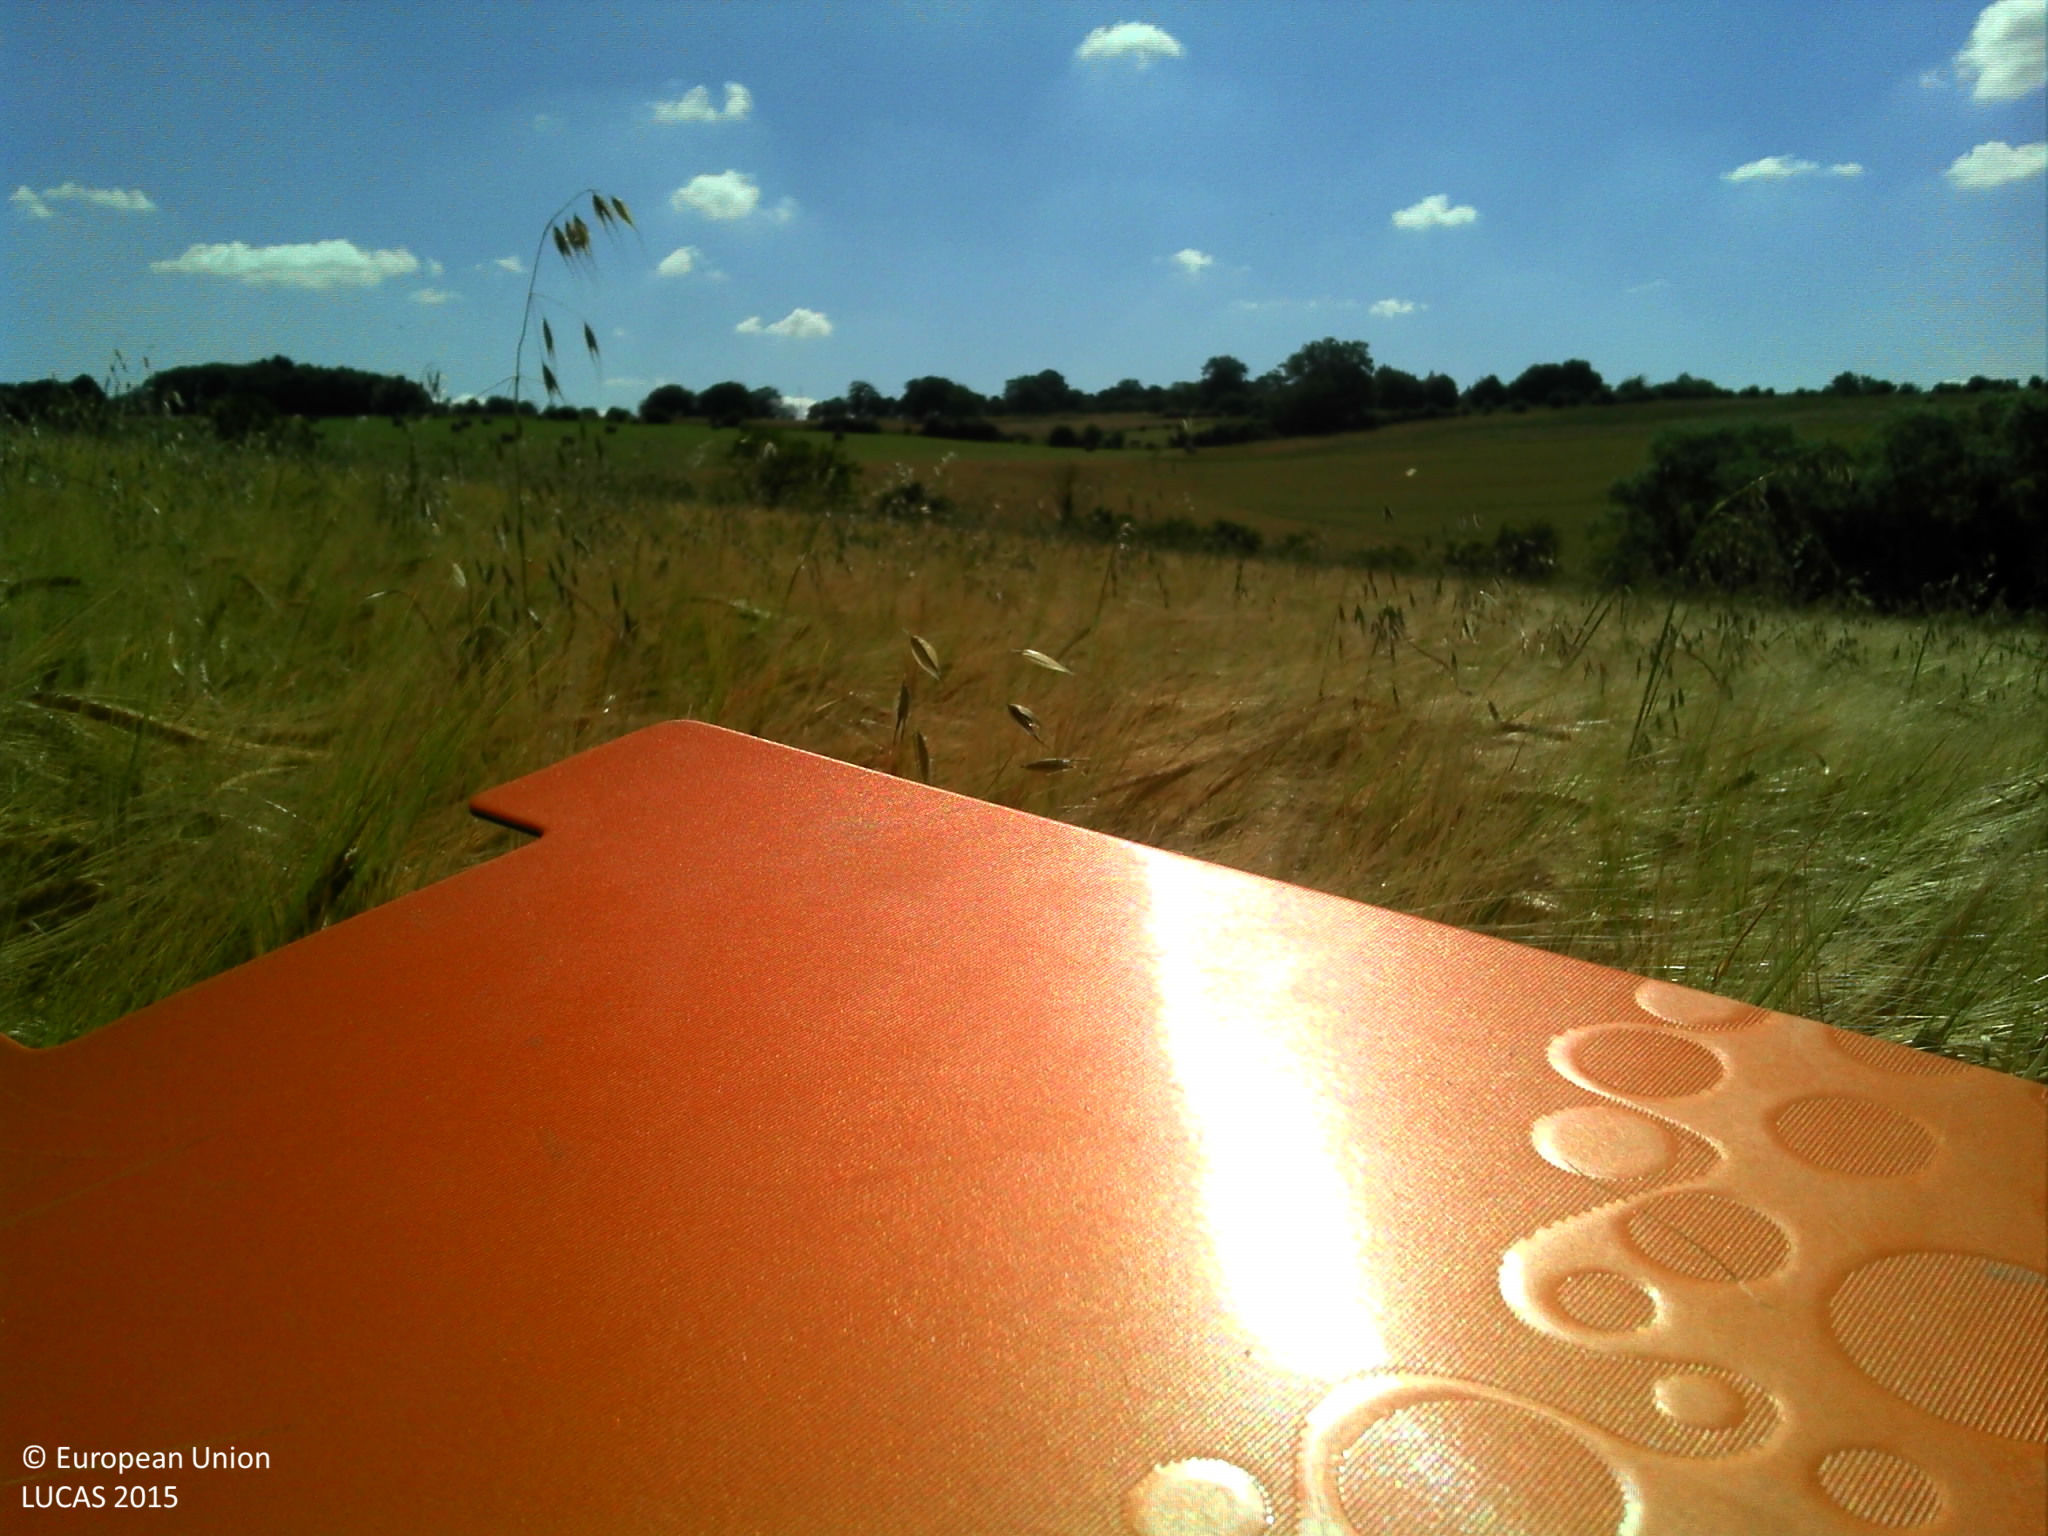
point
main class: Cropland
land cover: Barley
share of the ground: > 75 %
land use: Agriculture (excluding fallow land and kitchen gardens)
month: June
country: FR
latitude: 47.2523
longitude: 2.6070
